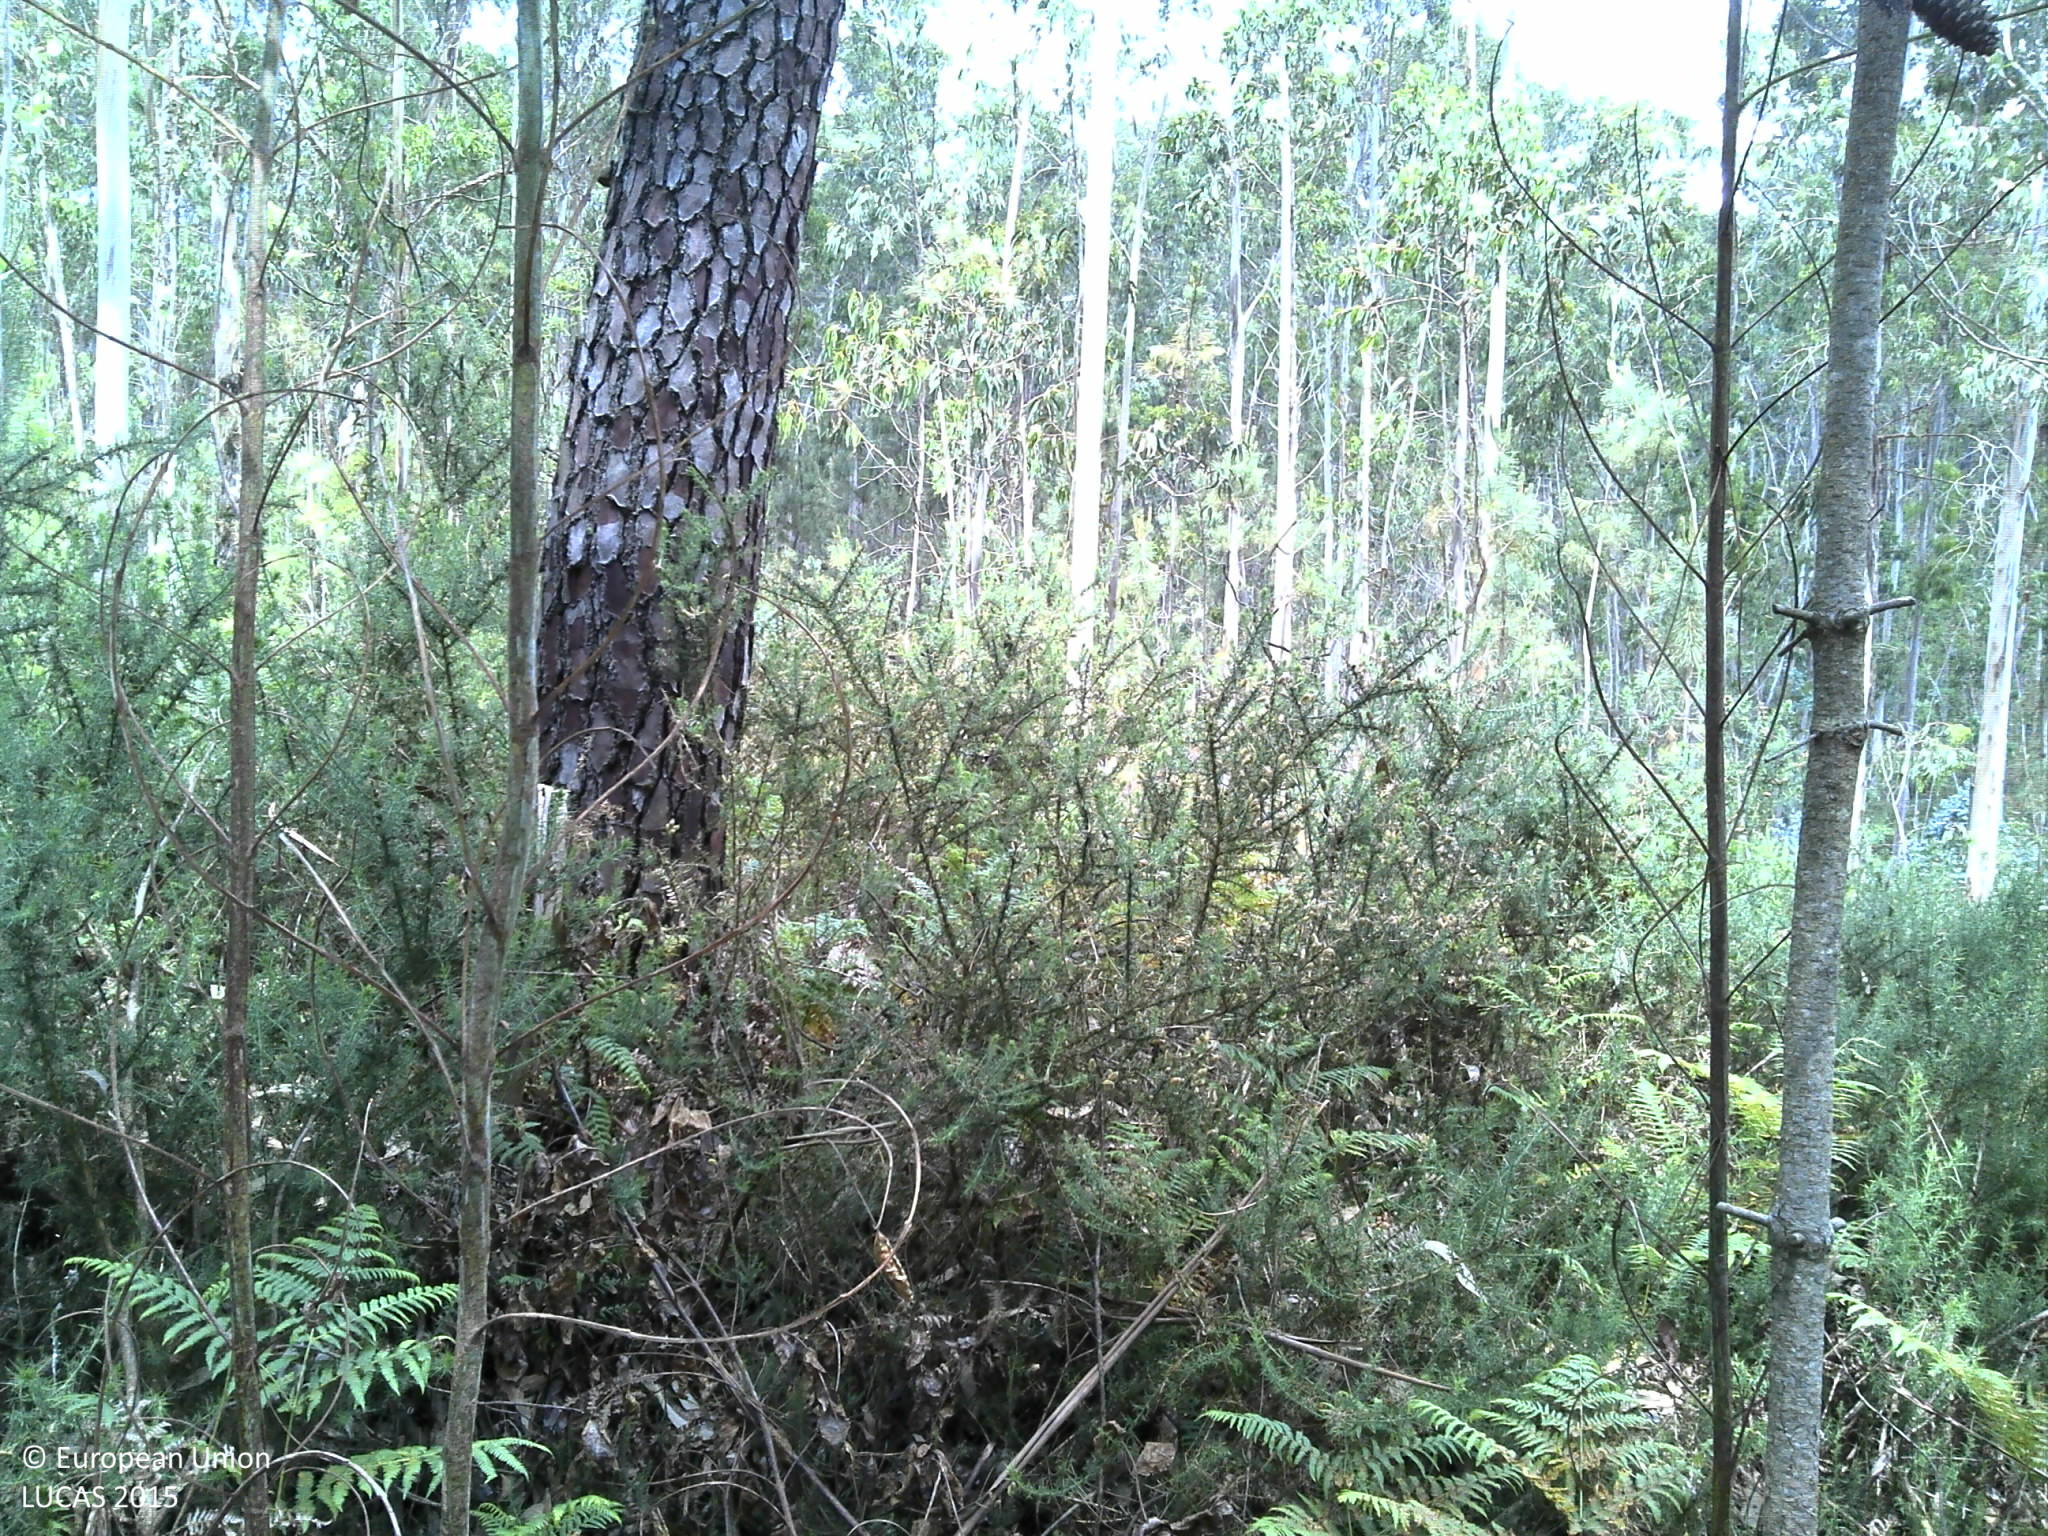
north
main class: Woodland
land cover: Broadleaved woodland
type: exotic forest
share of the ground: > 75 %
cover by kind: broadleaved forest trees 70 %, shrubs 20 %, herbaceous plants 5 %, unconsolidated bare surface 5 %
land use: Forestry
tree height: > 5 m
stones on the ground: < 10 %
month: May
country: PT
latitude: 41.4571
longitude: -8.6553
